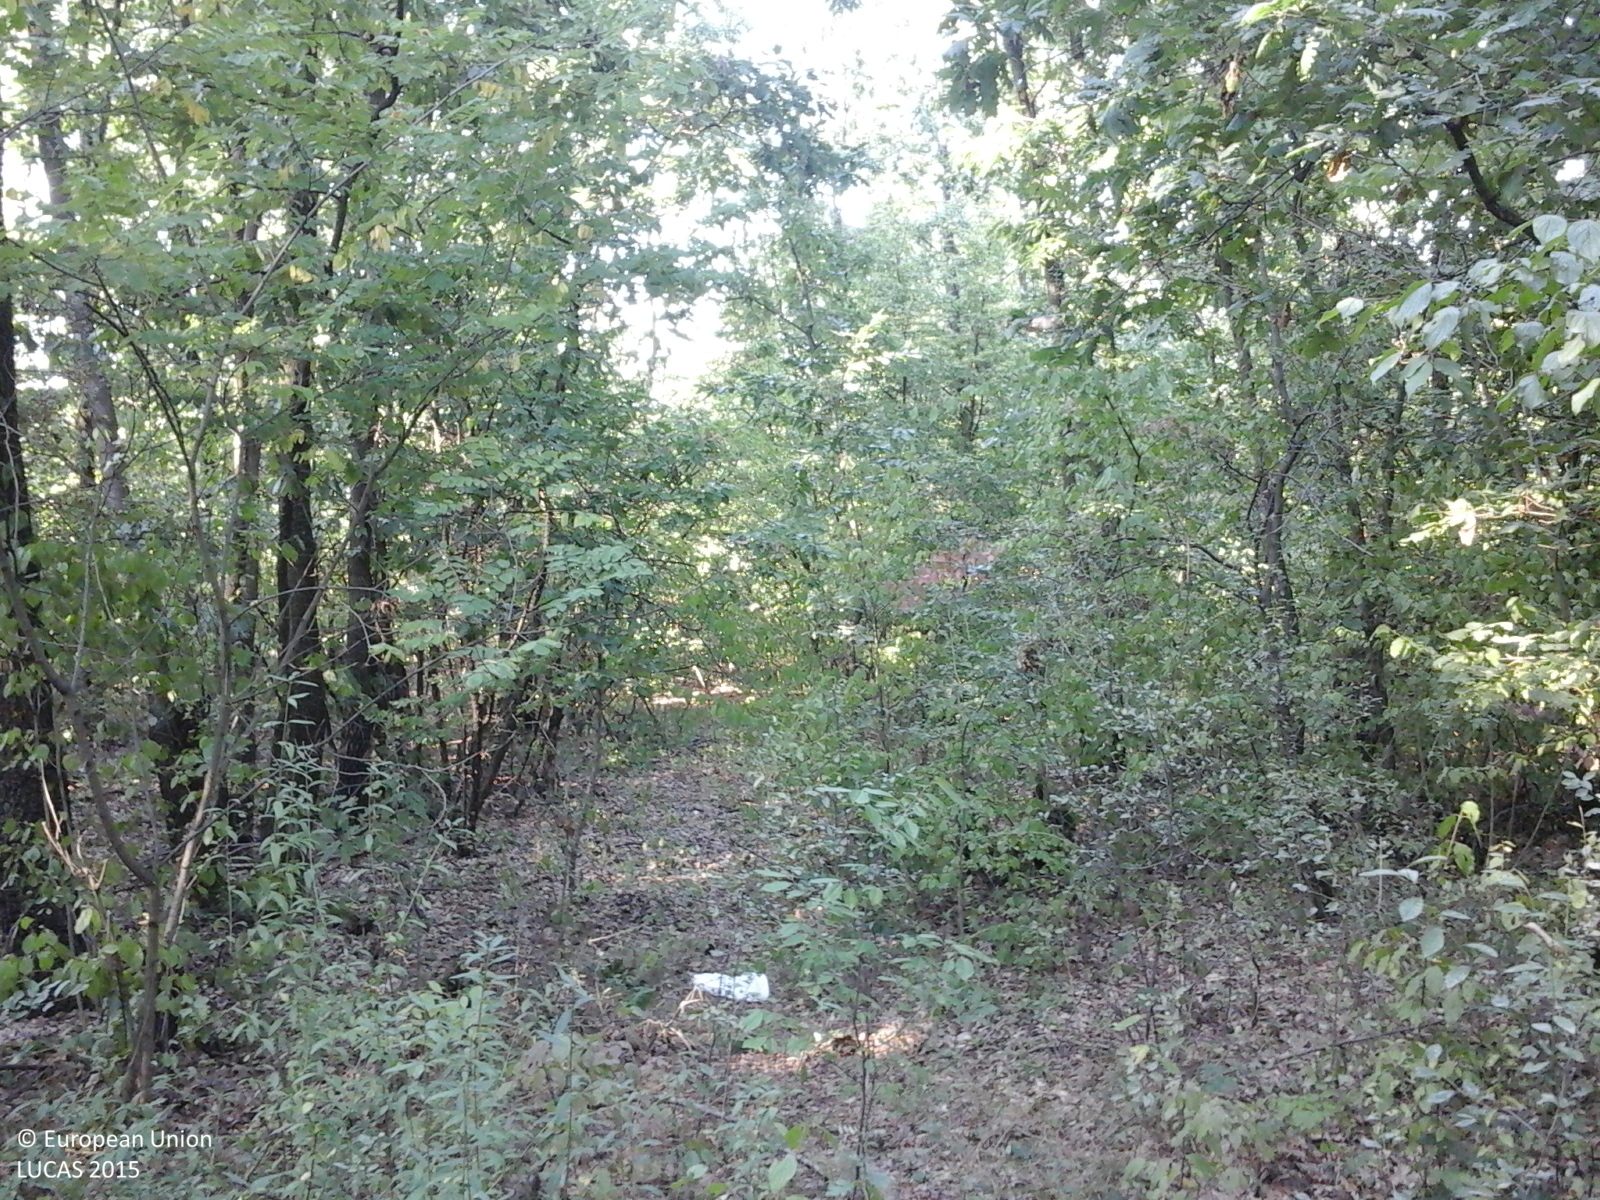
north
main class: Woodland
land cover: Broadleaved woodland
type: acidophilous oak and oak-birch forest
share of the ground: > 75 %
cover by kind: broadleaved forest trees 100 %
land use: Forestry
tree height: > 5 m
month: September
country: RO
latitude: 47.2483
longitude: 22.7030
